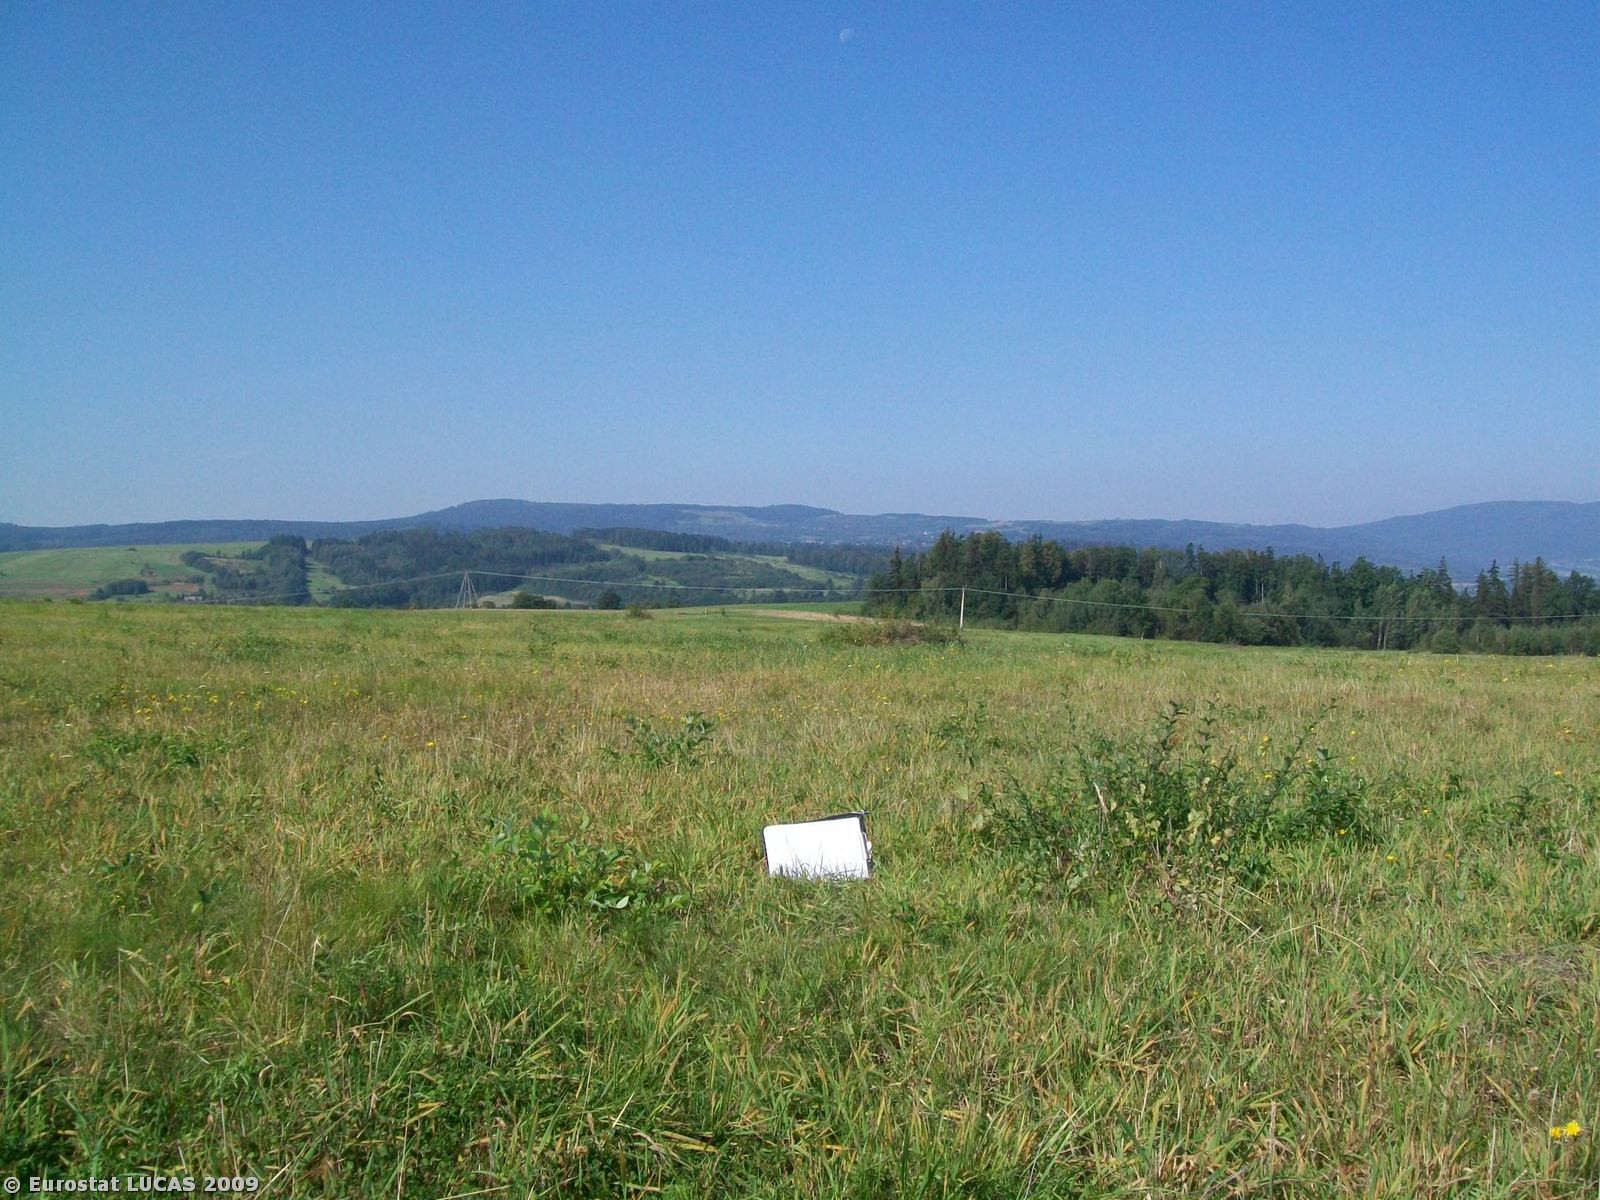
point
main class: Grassland
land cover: Grassland without tree/shrub cover
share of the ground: > 75 %
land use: Agriculture (excluding fallow land and kitchen gardens)
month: September
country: PL
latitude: 50.1863
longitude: 16.6890
